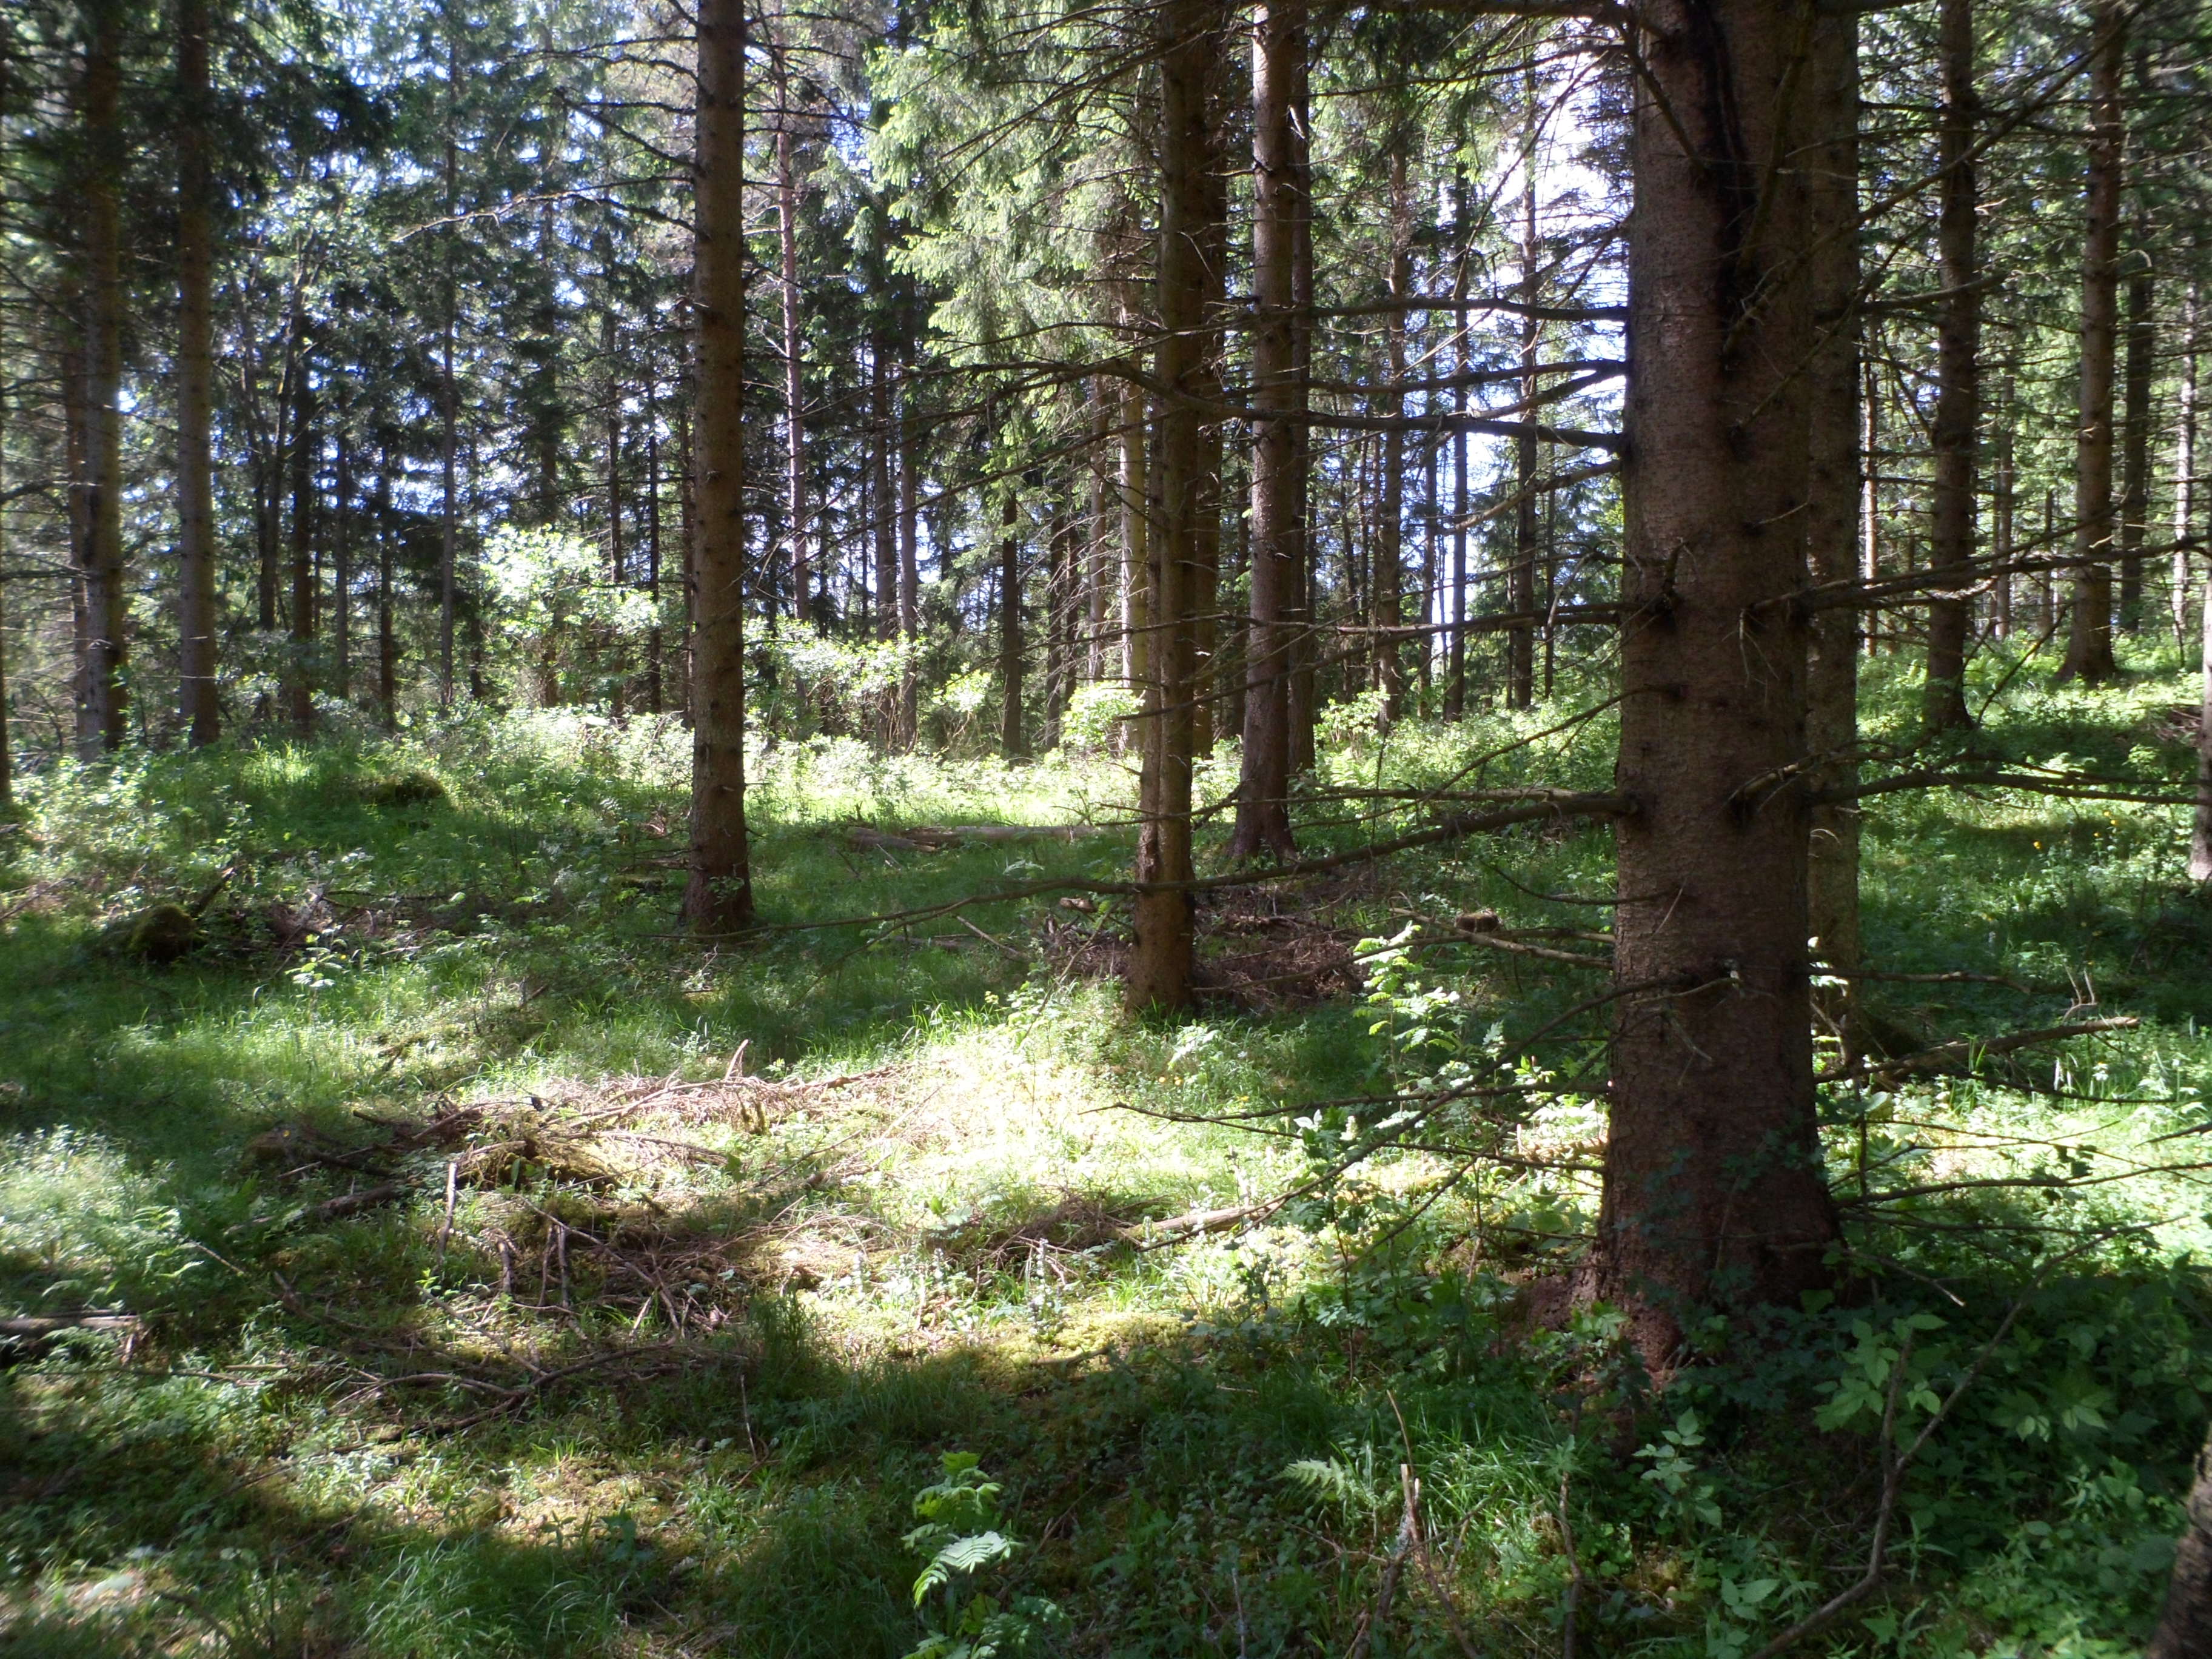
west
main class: Woodland
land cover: Spruce dominated coniferous woodland
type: boreal forest
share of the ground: 50 - 75 %
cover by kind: coniferous forest trees 60 %, herbaceous plants 20 %, shrubs 10 %, broadleaved forest trees 5 %, lichens and mosses 5 %
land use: Forestry
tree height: > 5 m
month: June
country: SE
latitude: 57.5060
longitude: 14.1847
